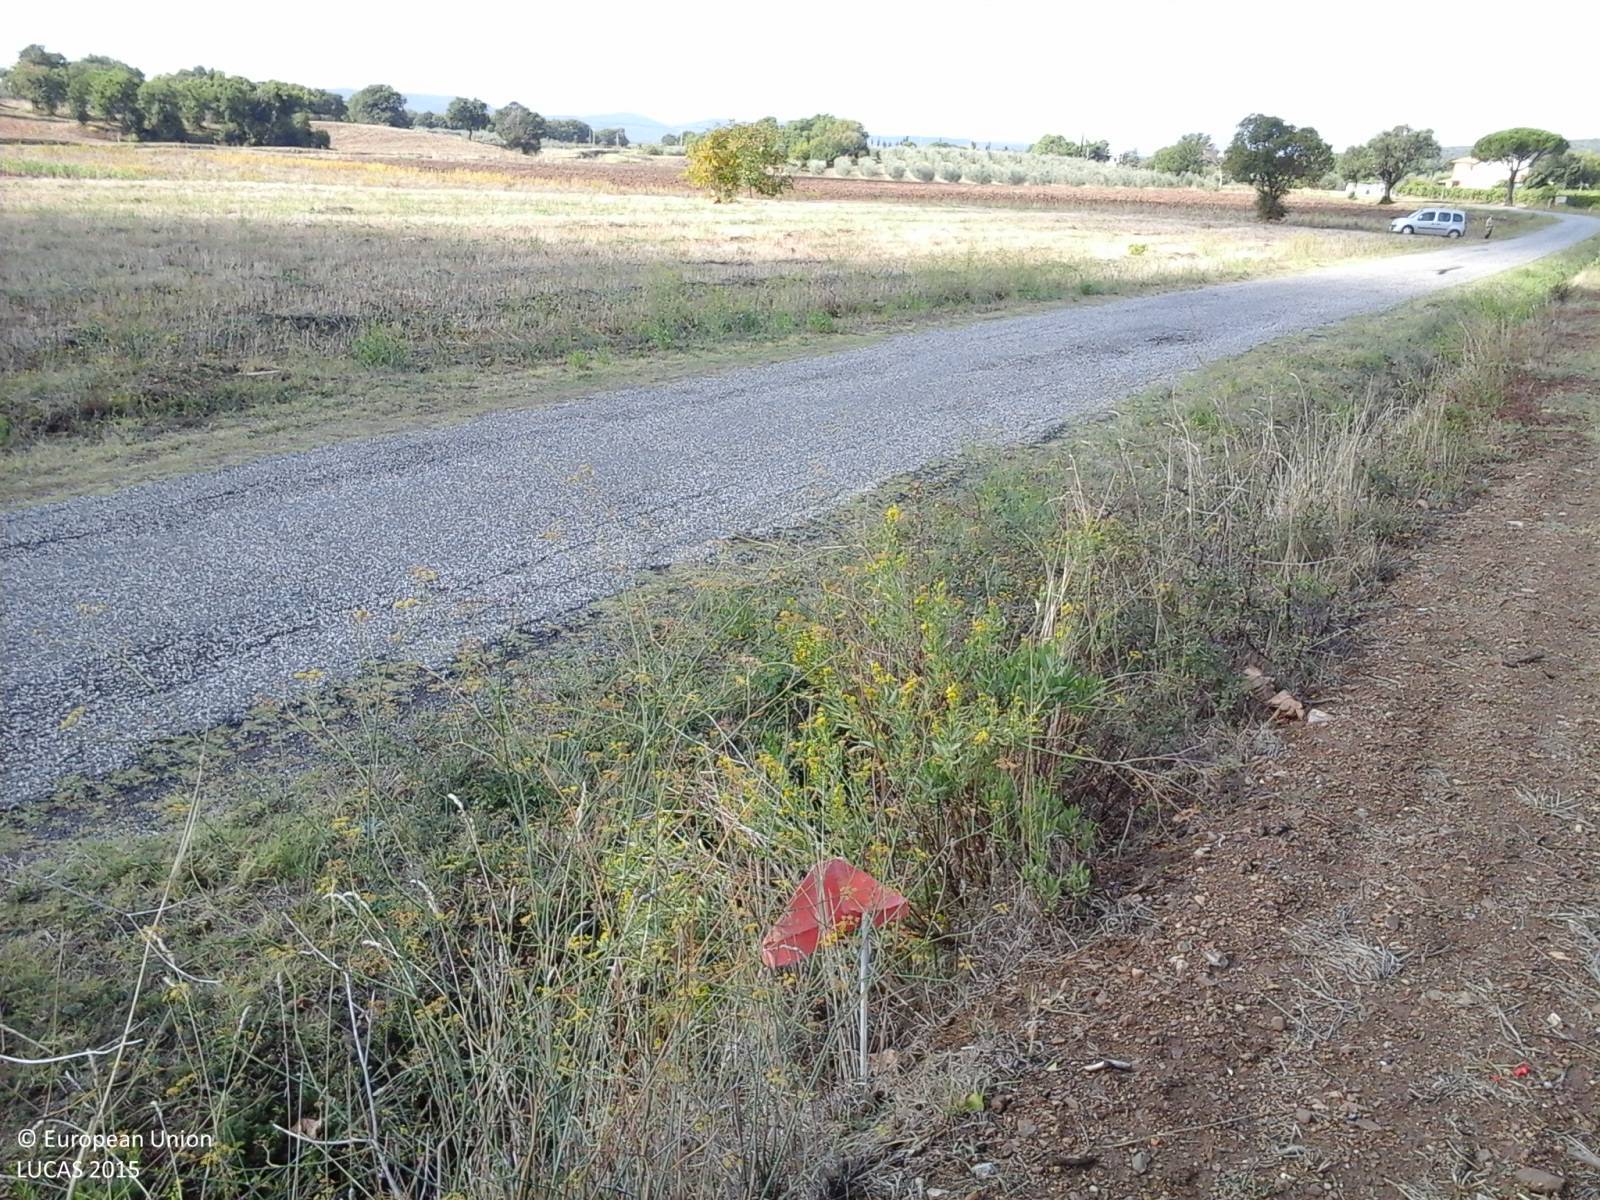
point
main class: Cropland
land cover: Vineyards
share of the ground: 10 - 25 %
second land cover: Other bare soil
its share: > 75 %
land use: Agriculture (excluding fallow land and kitchen gardens)
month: October
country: IT
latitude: 43.0297
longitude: 10.8442
